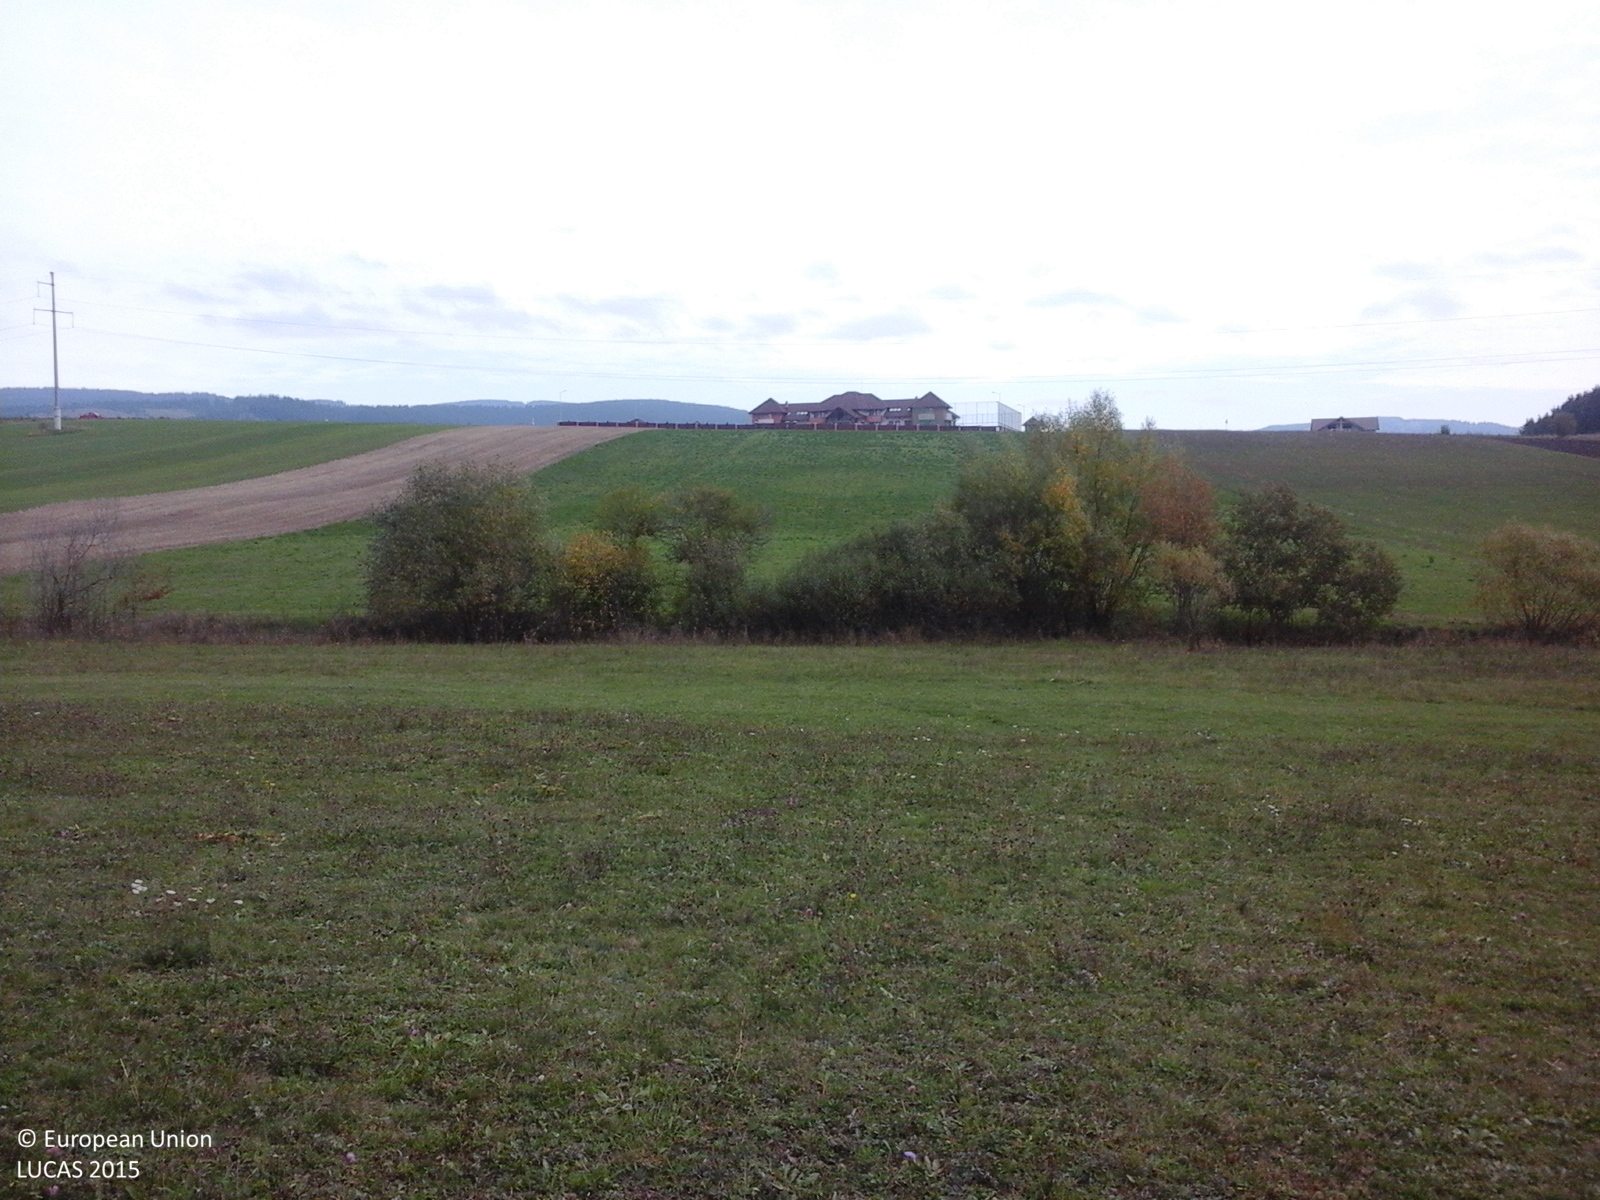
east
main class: Grassland
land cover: Grassland without tree/shrub cover
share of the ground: > 75 %
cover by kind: herbaceous plants 100 %
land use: Agriculture (excluding fallow land and kitchen gardens)
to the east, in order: Grassland without tree/shrub cover; Abandoned hedges; Ditches and canals; Abandoned hedges; Lucerne
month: October
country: RO
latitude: 46.4119
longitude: 25.8180
